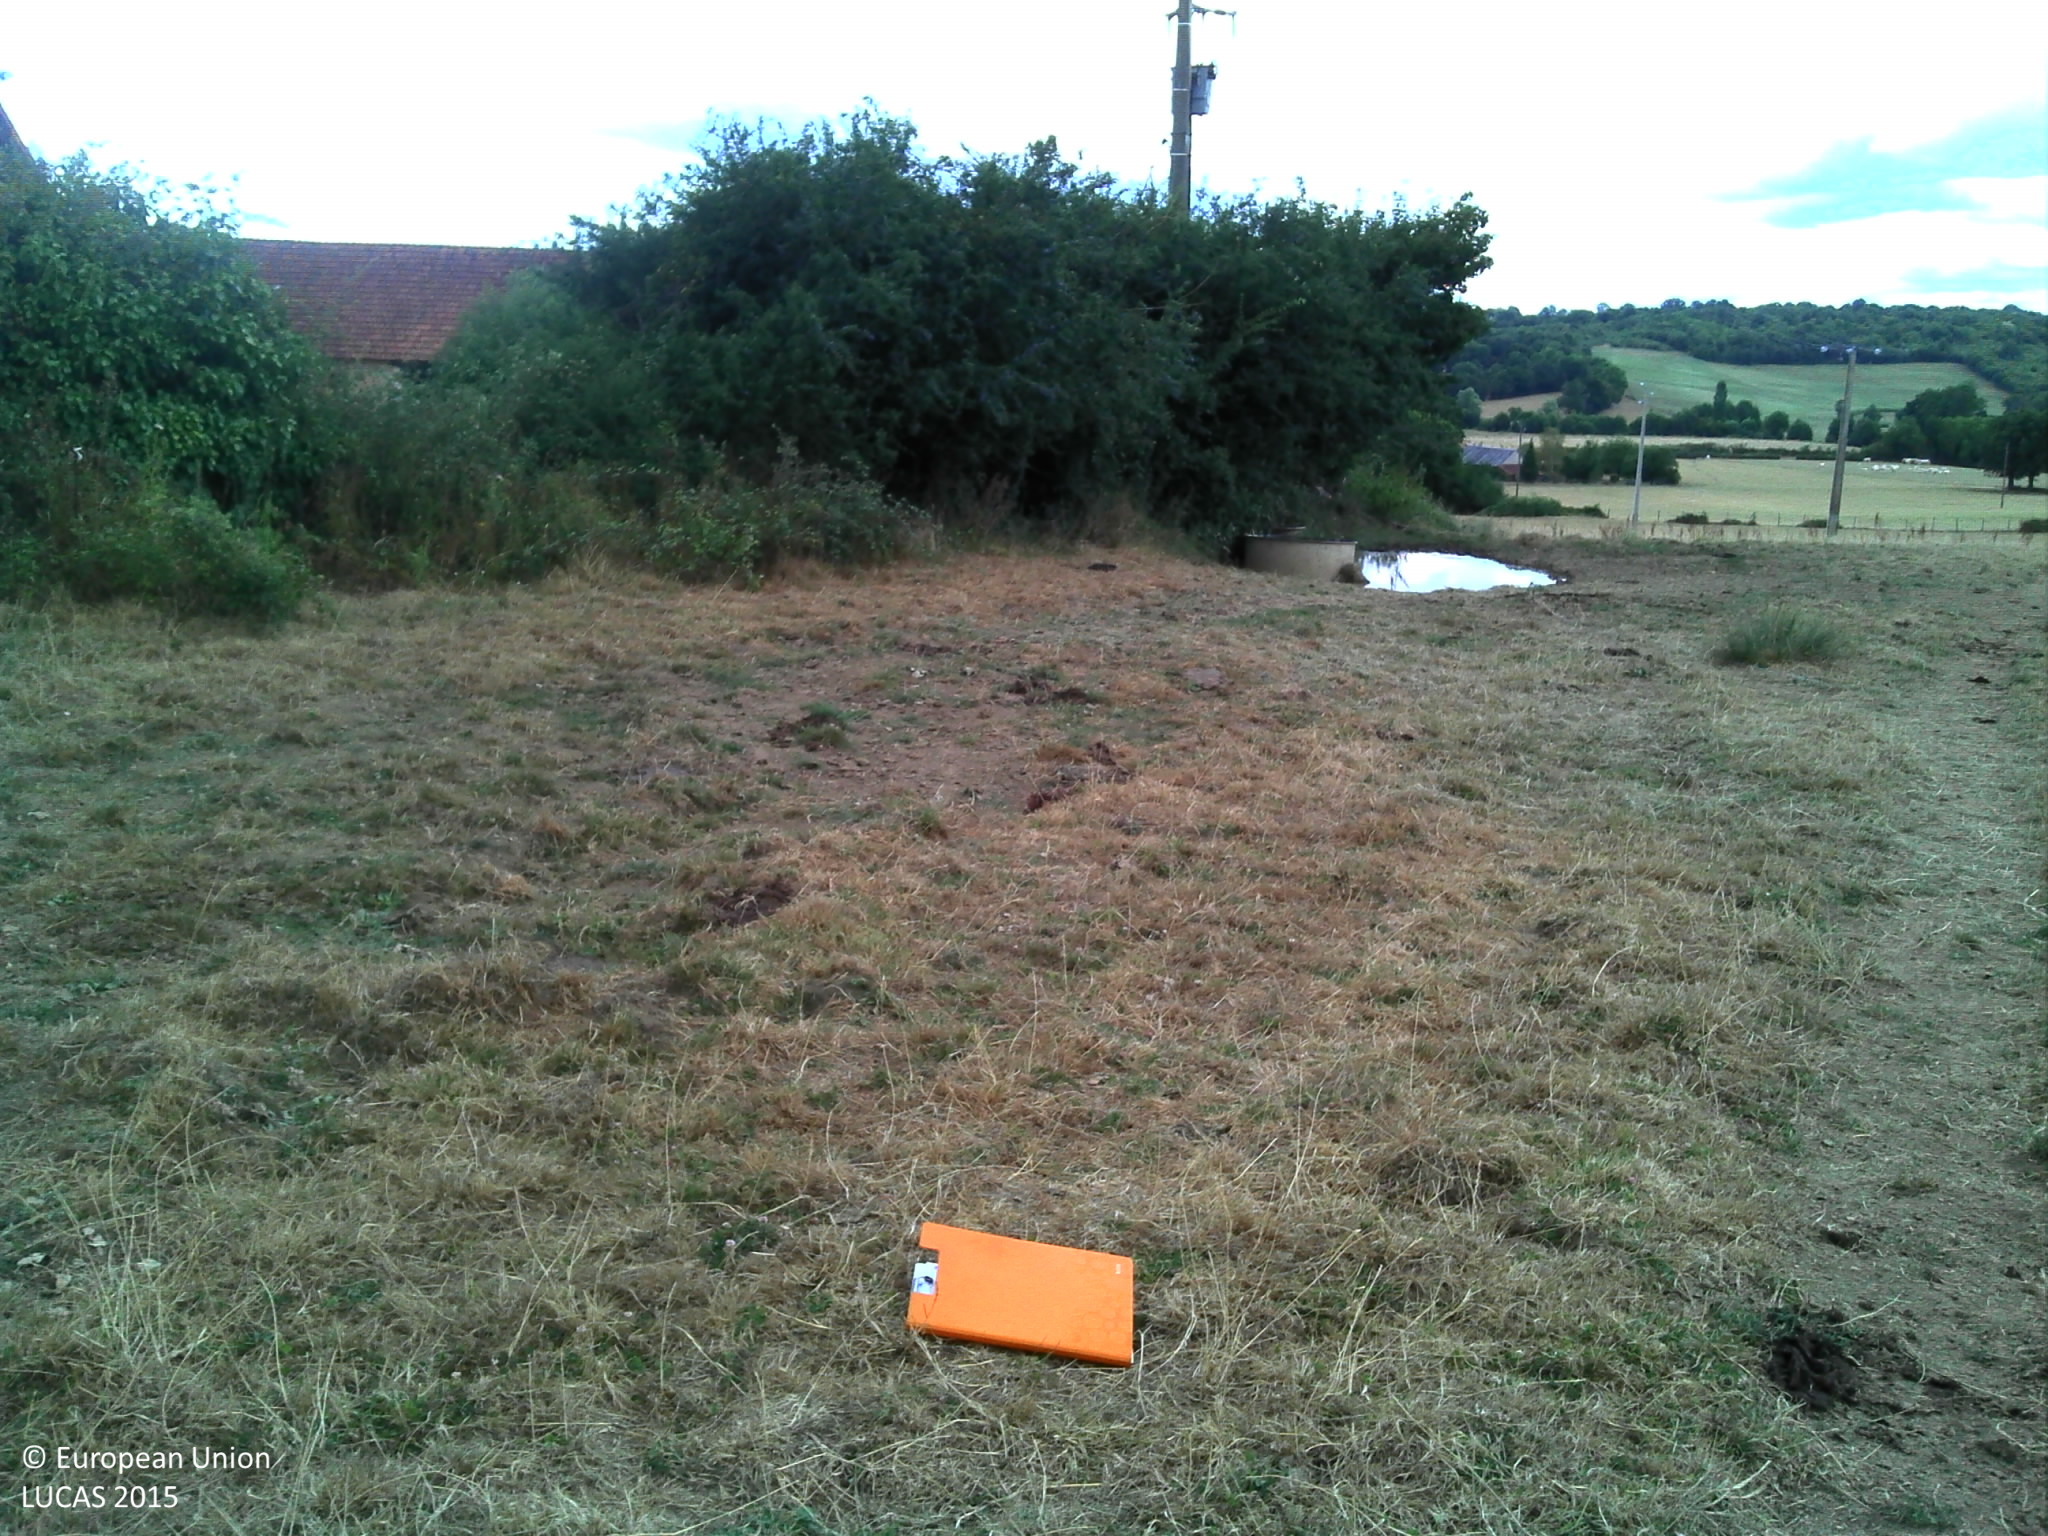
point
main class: Grassland
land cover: Grassland without tree/shrub cover
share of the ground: > 75 %
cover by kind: herbaceous plants 100 %
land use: Agriculture (excluding fallow land and kitchen gardens)
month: July
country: FR
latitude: 46.6605
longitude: 2.1647
